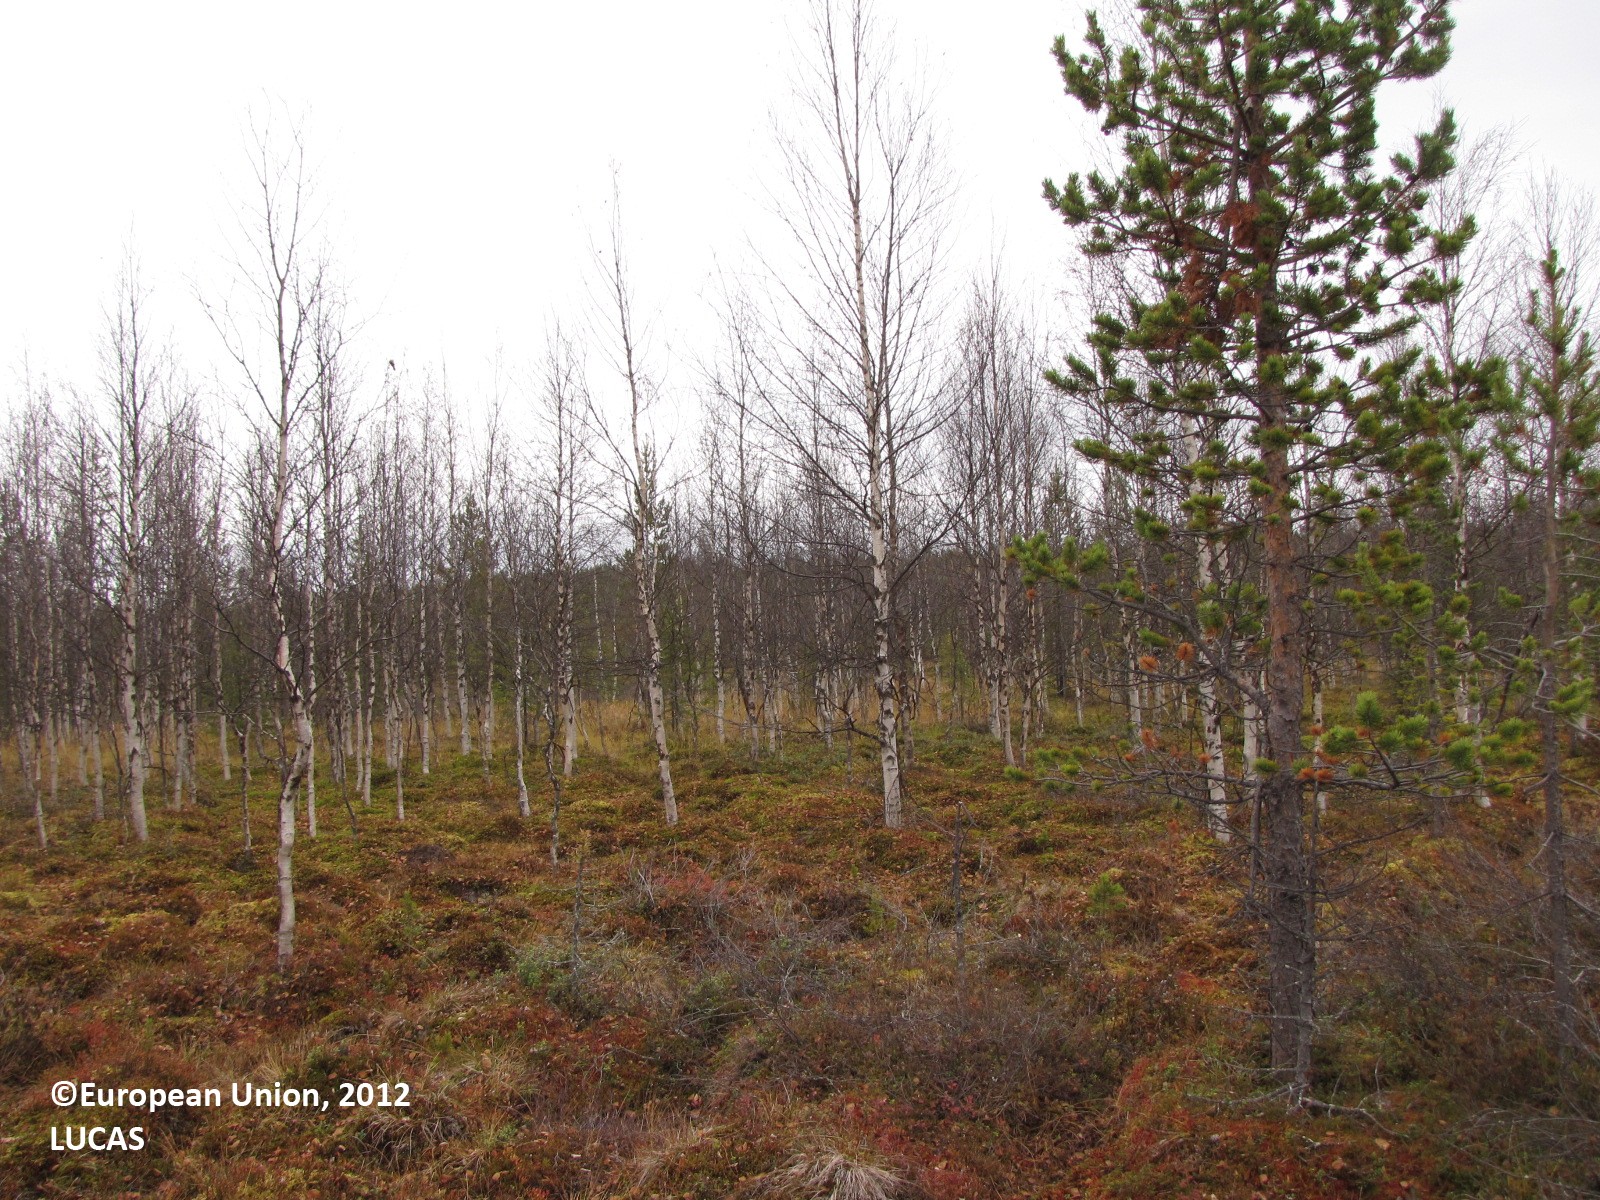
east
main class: Woodland
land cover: Pine dominated mixed woodland
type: boreal forest
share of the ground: 25 - 50 %
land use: Forestry
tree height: > 5 m
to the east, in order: Pine dominated mixed woodland; Broadleaved woodland; Other mixed woodland; Ditches and canals; Spruce dominated mixed woodland; Ditches and canals; Pine dominated mixed woodland
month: September
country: FI
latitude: 67.6751
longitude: 24.1055
